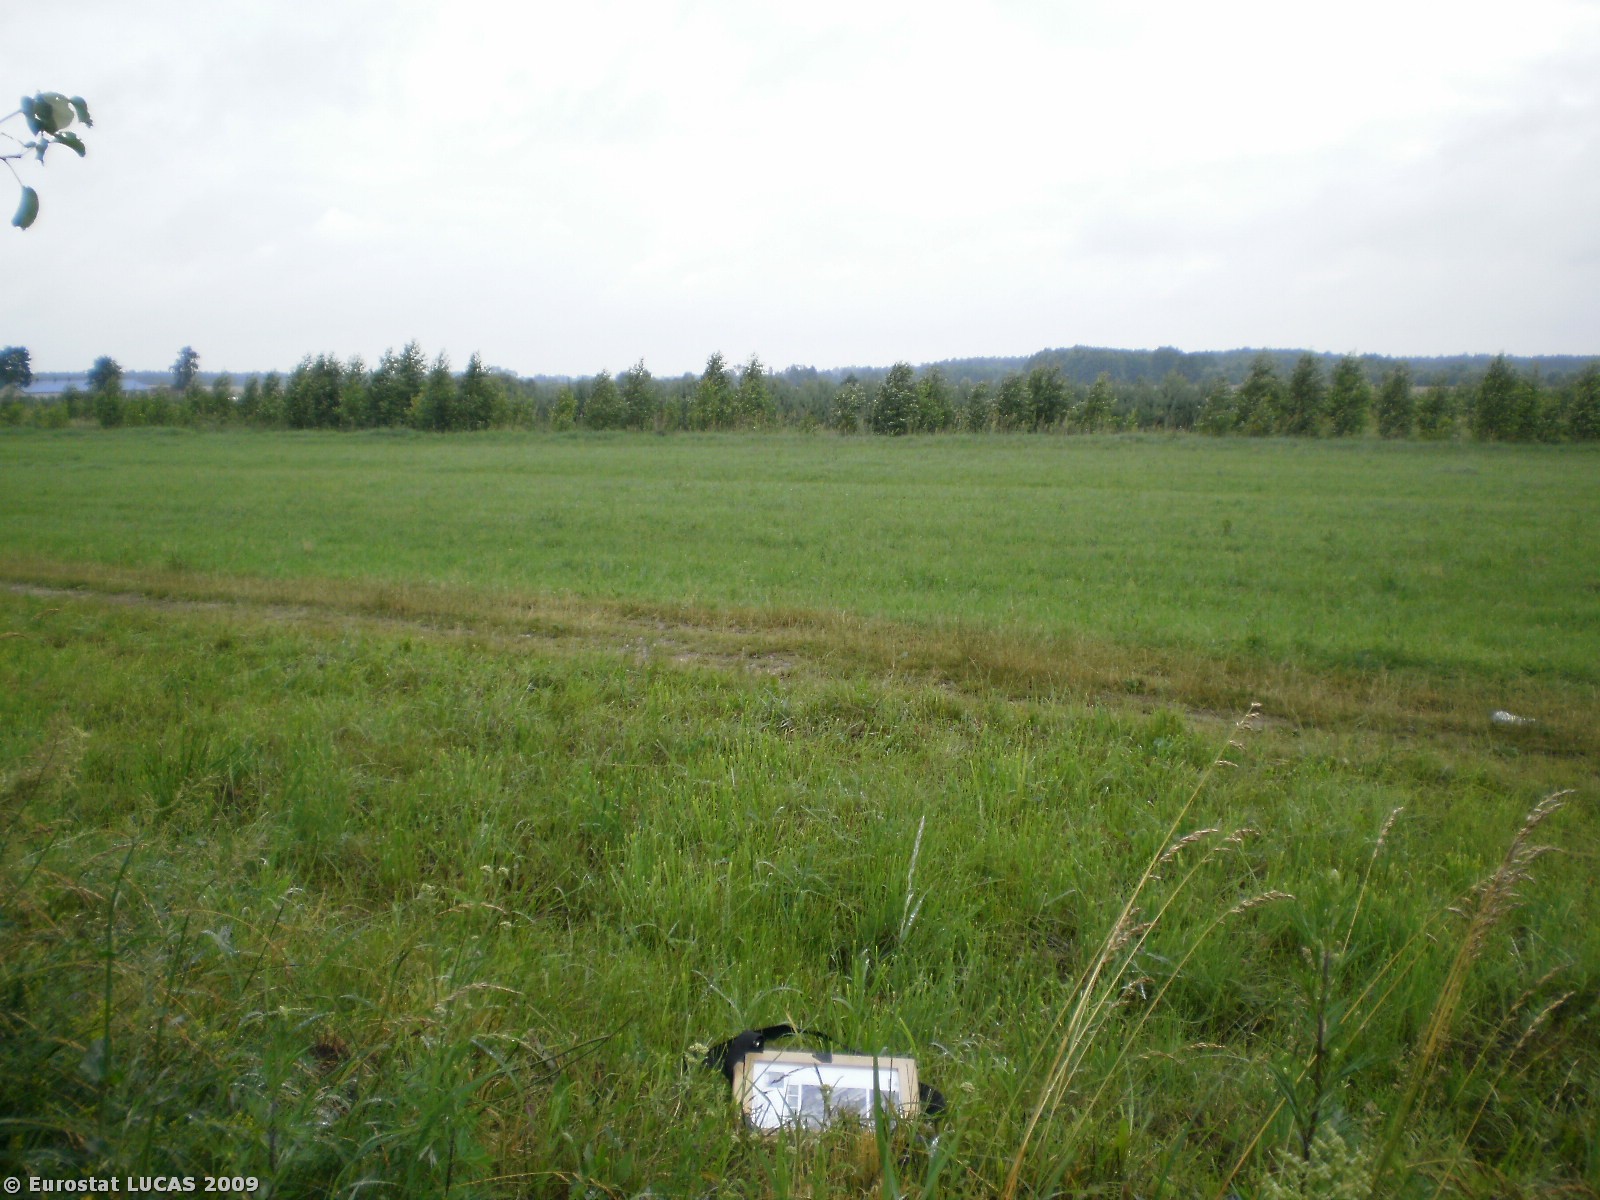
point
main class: Grassland
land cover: Grassland without tree/shrub cover
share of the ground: > 75 %
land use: Agriculture (excluding fallow land and kitchen gardens)
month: July
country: PL
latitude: 53.0940
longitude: 20.4454
